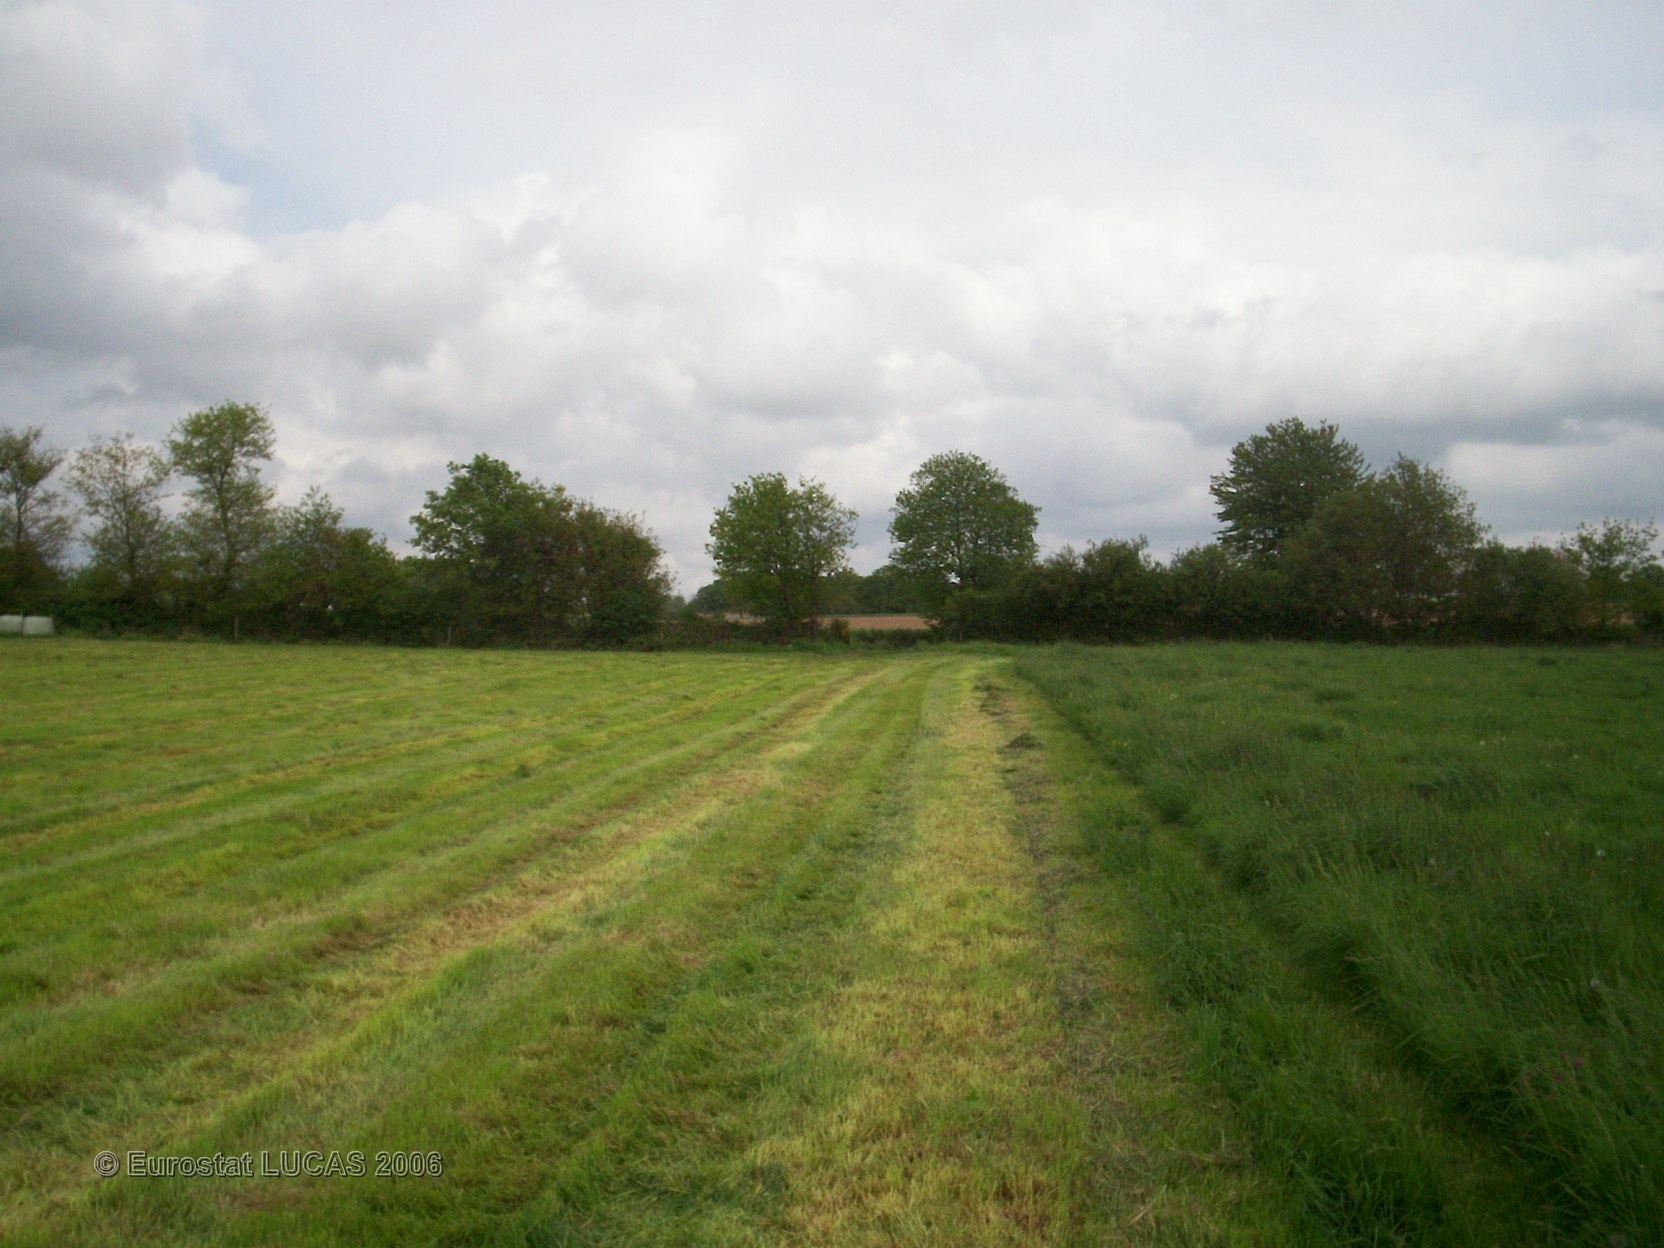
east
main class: Grassland
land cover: Grassland without tree/shrub cover
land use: Agriculture (excluding fallow land and kitchen gardens)
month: May
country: FR
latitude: 47.9434
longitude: -2.3607
